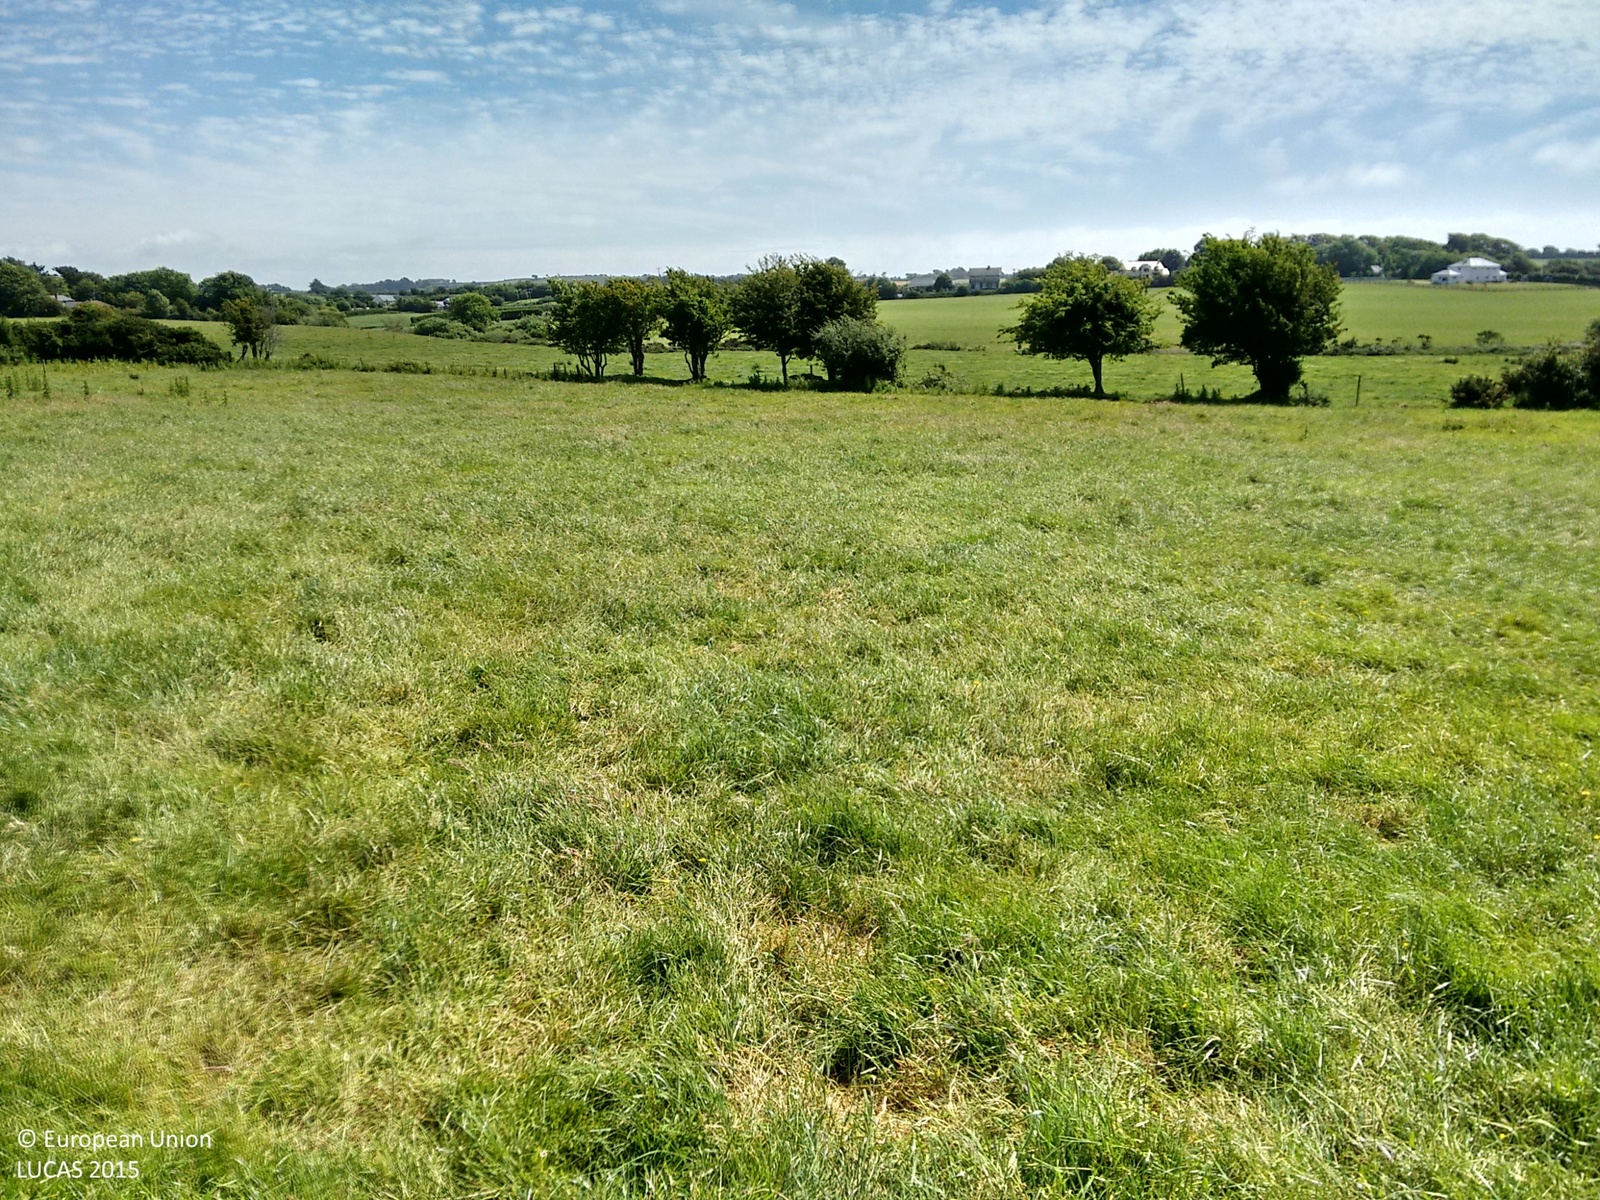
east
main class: Grassland
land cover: Grassland without tree/shrub cover
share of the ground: > 75 %
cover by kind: herbaceous plants 100 %
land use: Agriculture (excluding fallow land and kitchen gardens)
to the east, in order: Grassland without tree/shrub cover; Fences; Grassland without tree/shrub cover; Shrubland without tree cover; Fences; Grassland without tree/shrub cover
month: June
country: IE
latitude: 52.2162
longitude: -7.0498
